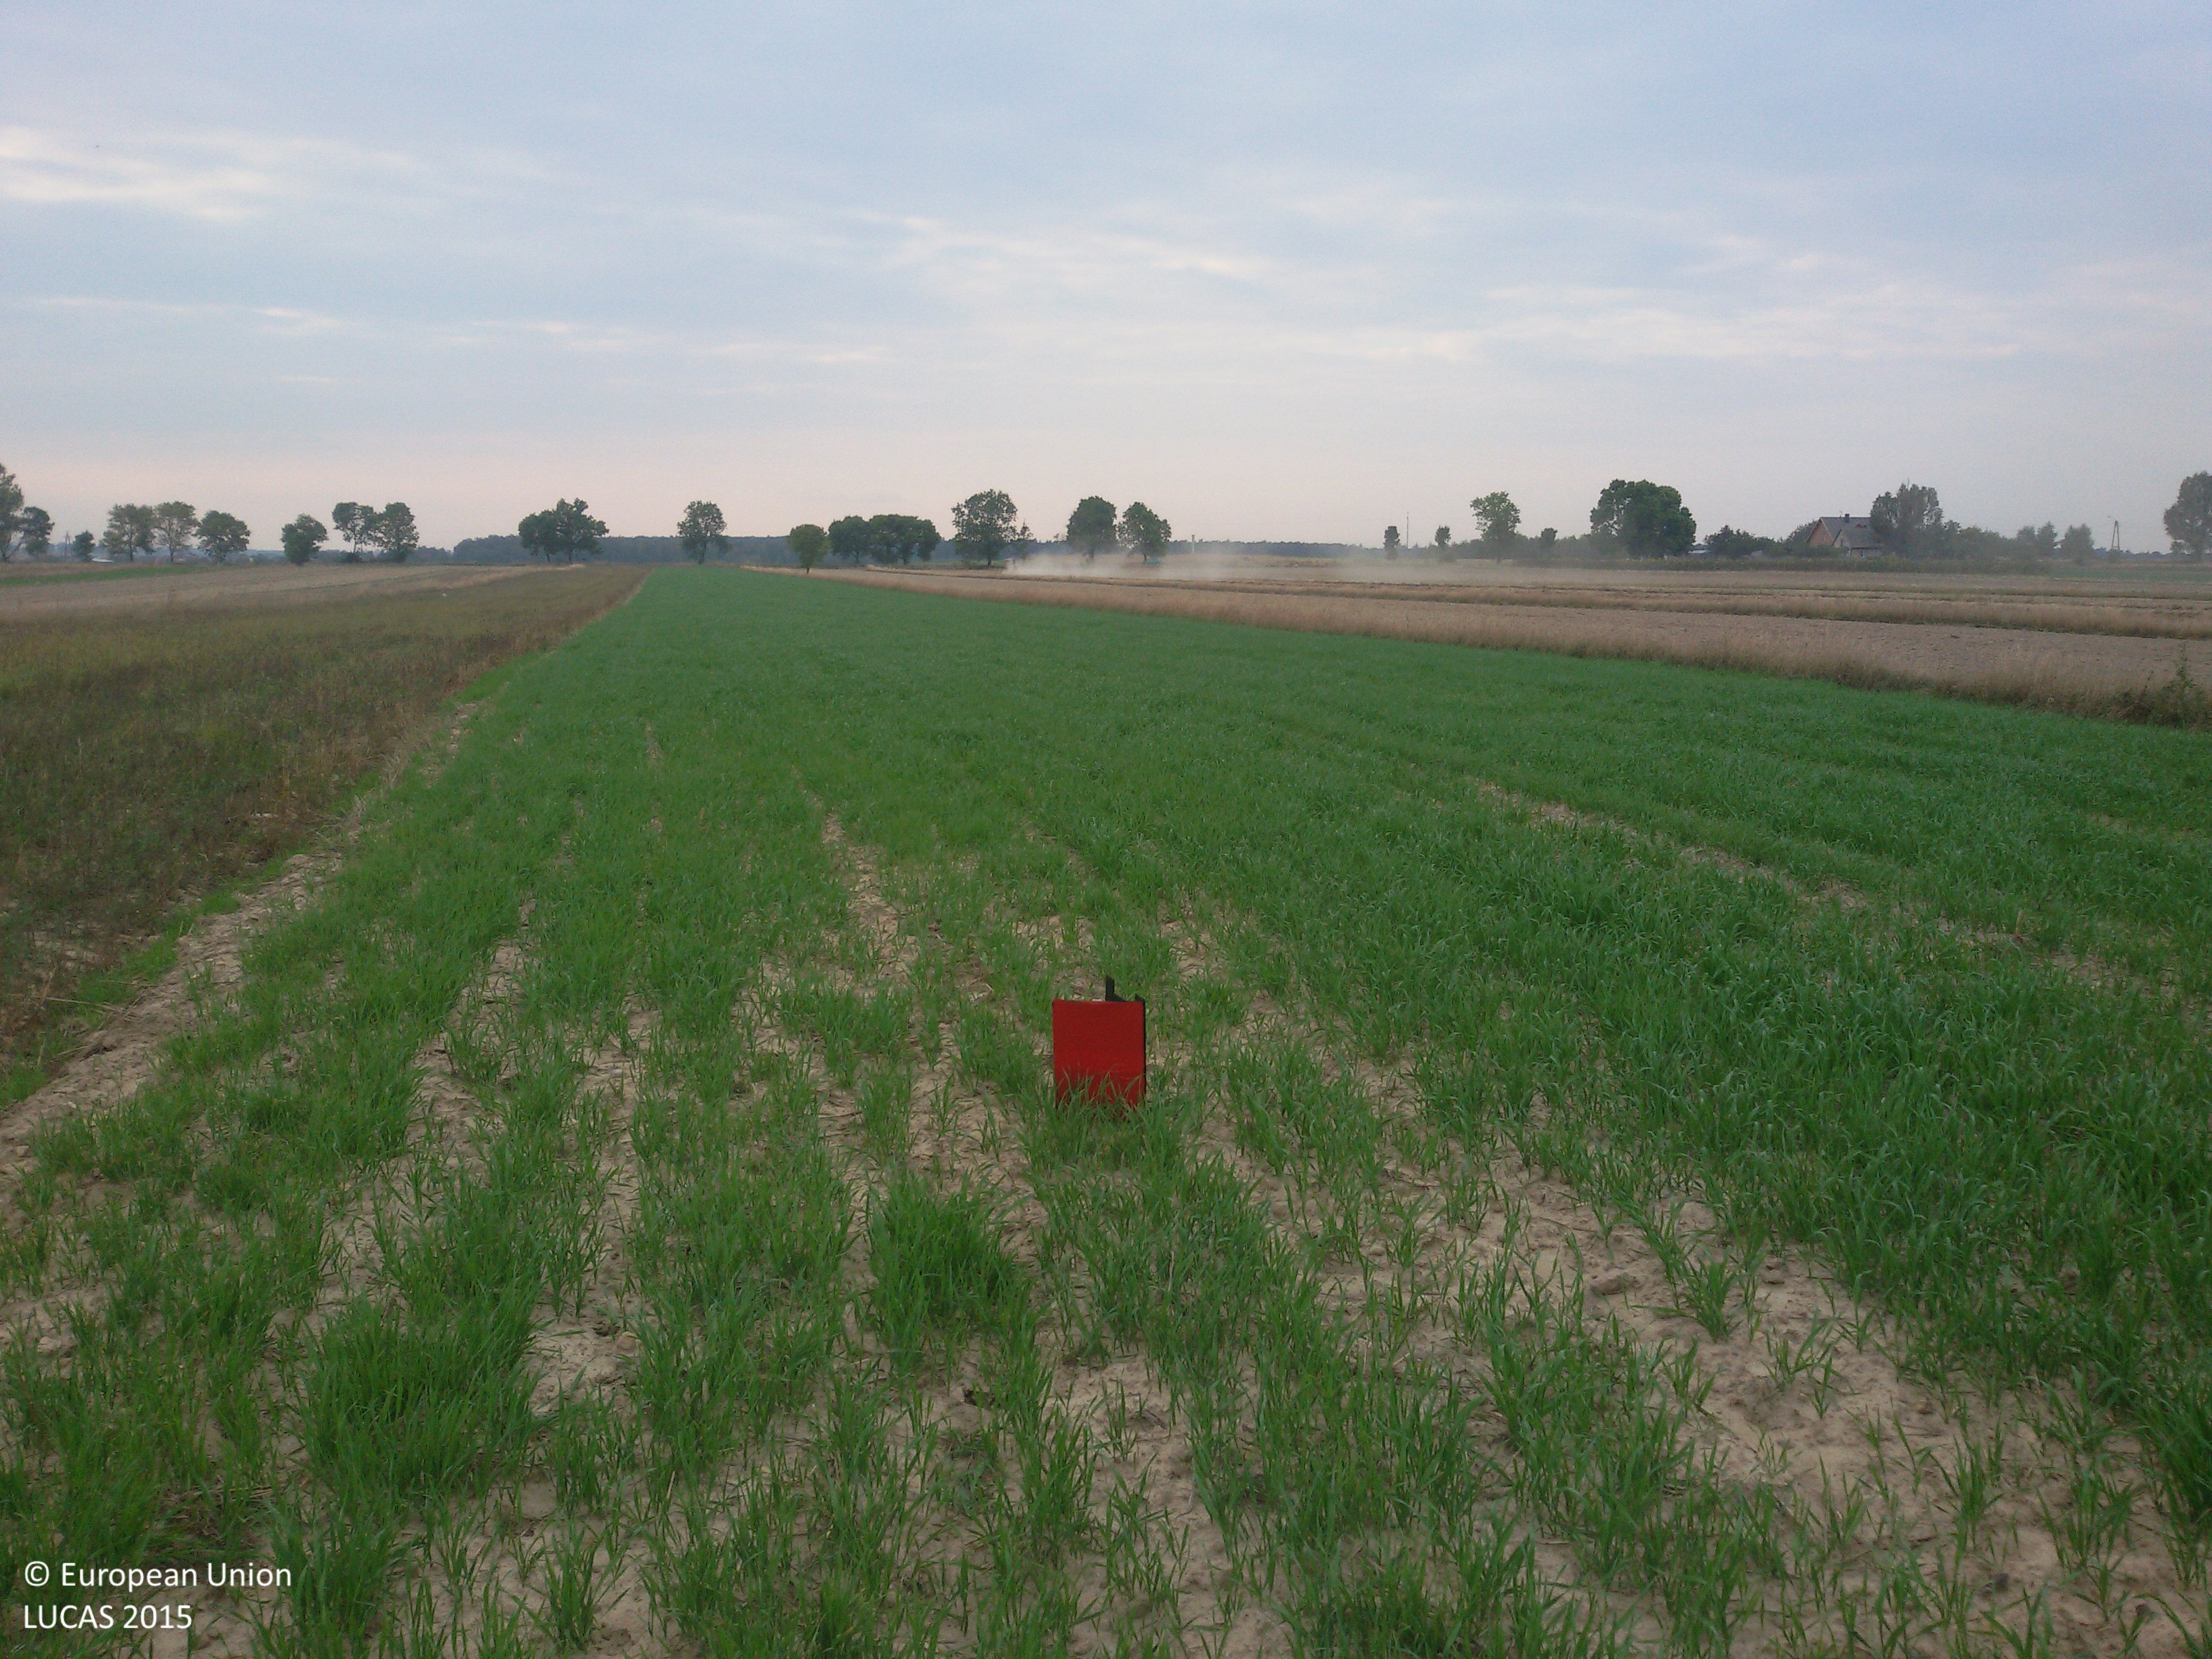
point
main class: Cropland
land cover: Common wheat
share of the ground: 50 - 75 %
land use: Agriculture (excluding fallow land and kitchen gardens)
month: September
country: PL
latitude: 51.0022
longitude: 18.7856
